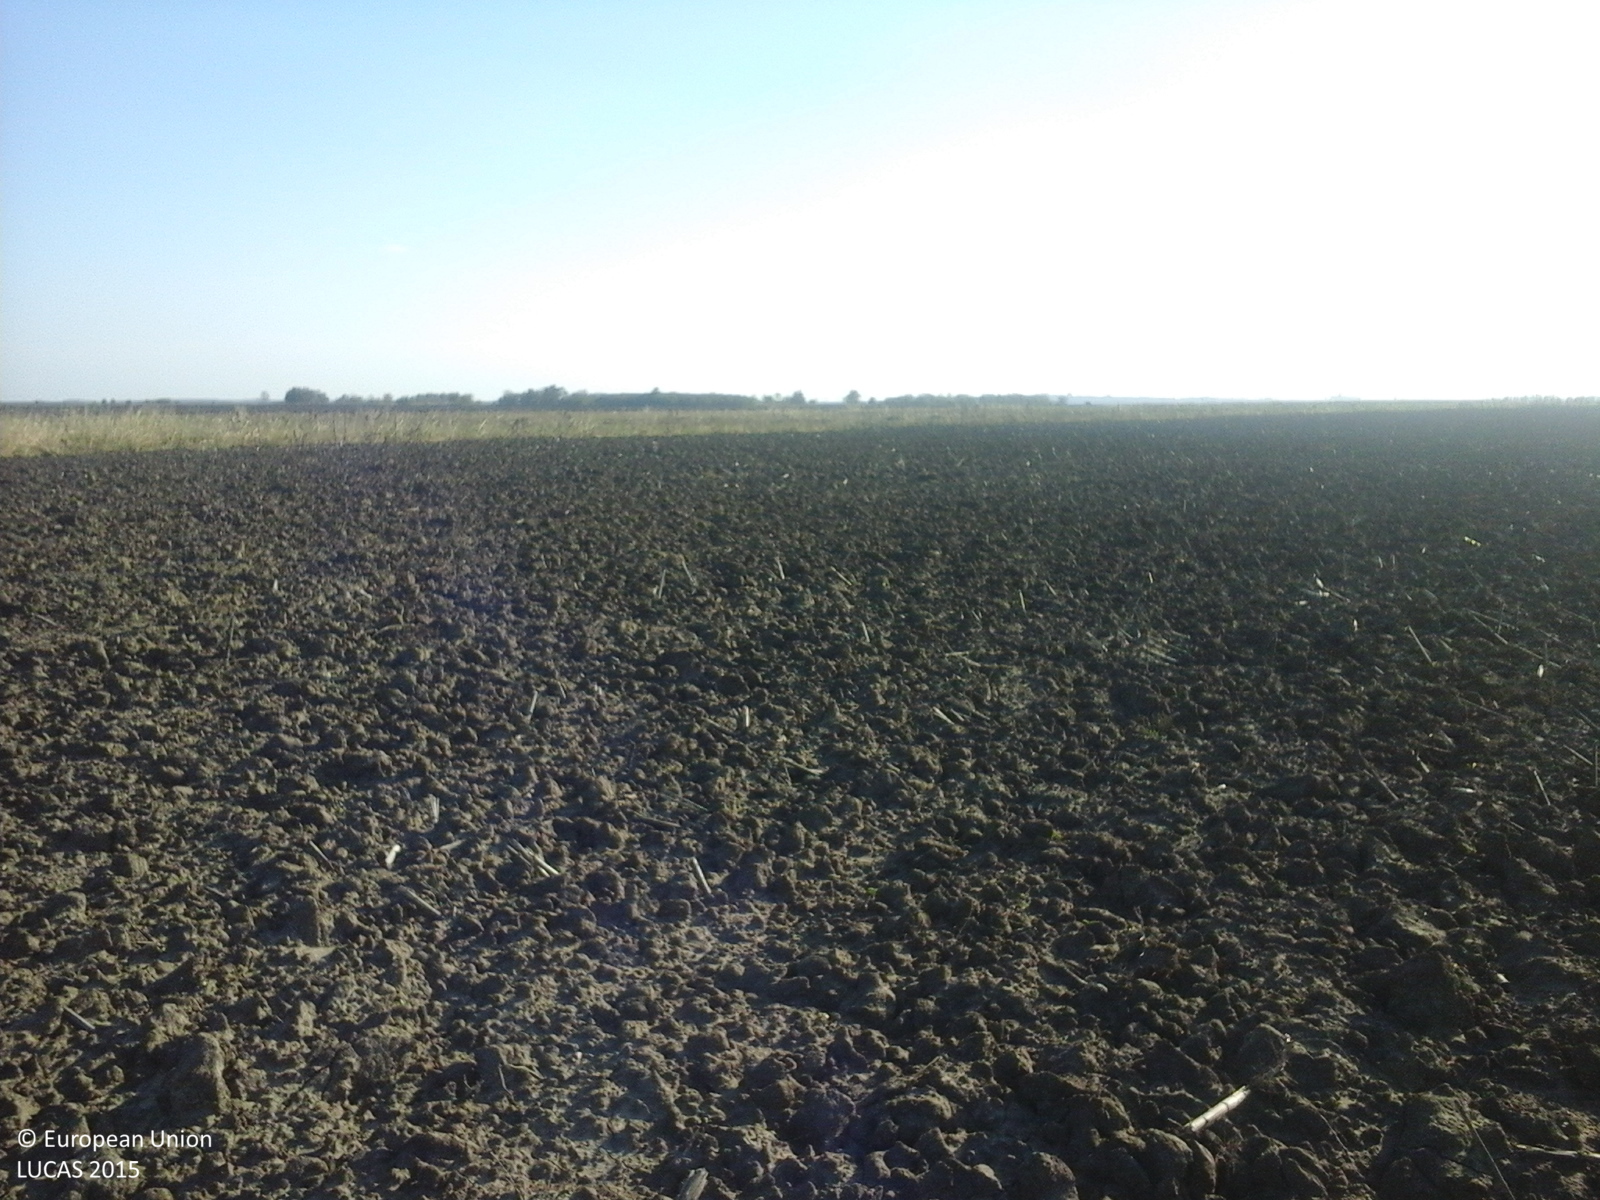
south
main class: Cropland
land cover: Sunflower
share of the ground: < 10 %
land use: Agriculture (excluding fallow land and kitchen gardens)
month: October
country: RO
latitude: 45.2572
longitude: 27.3104
